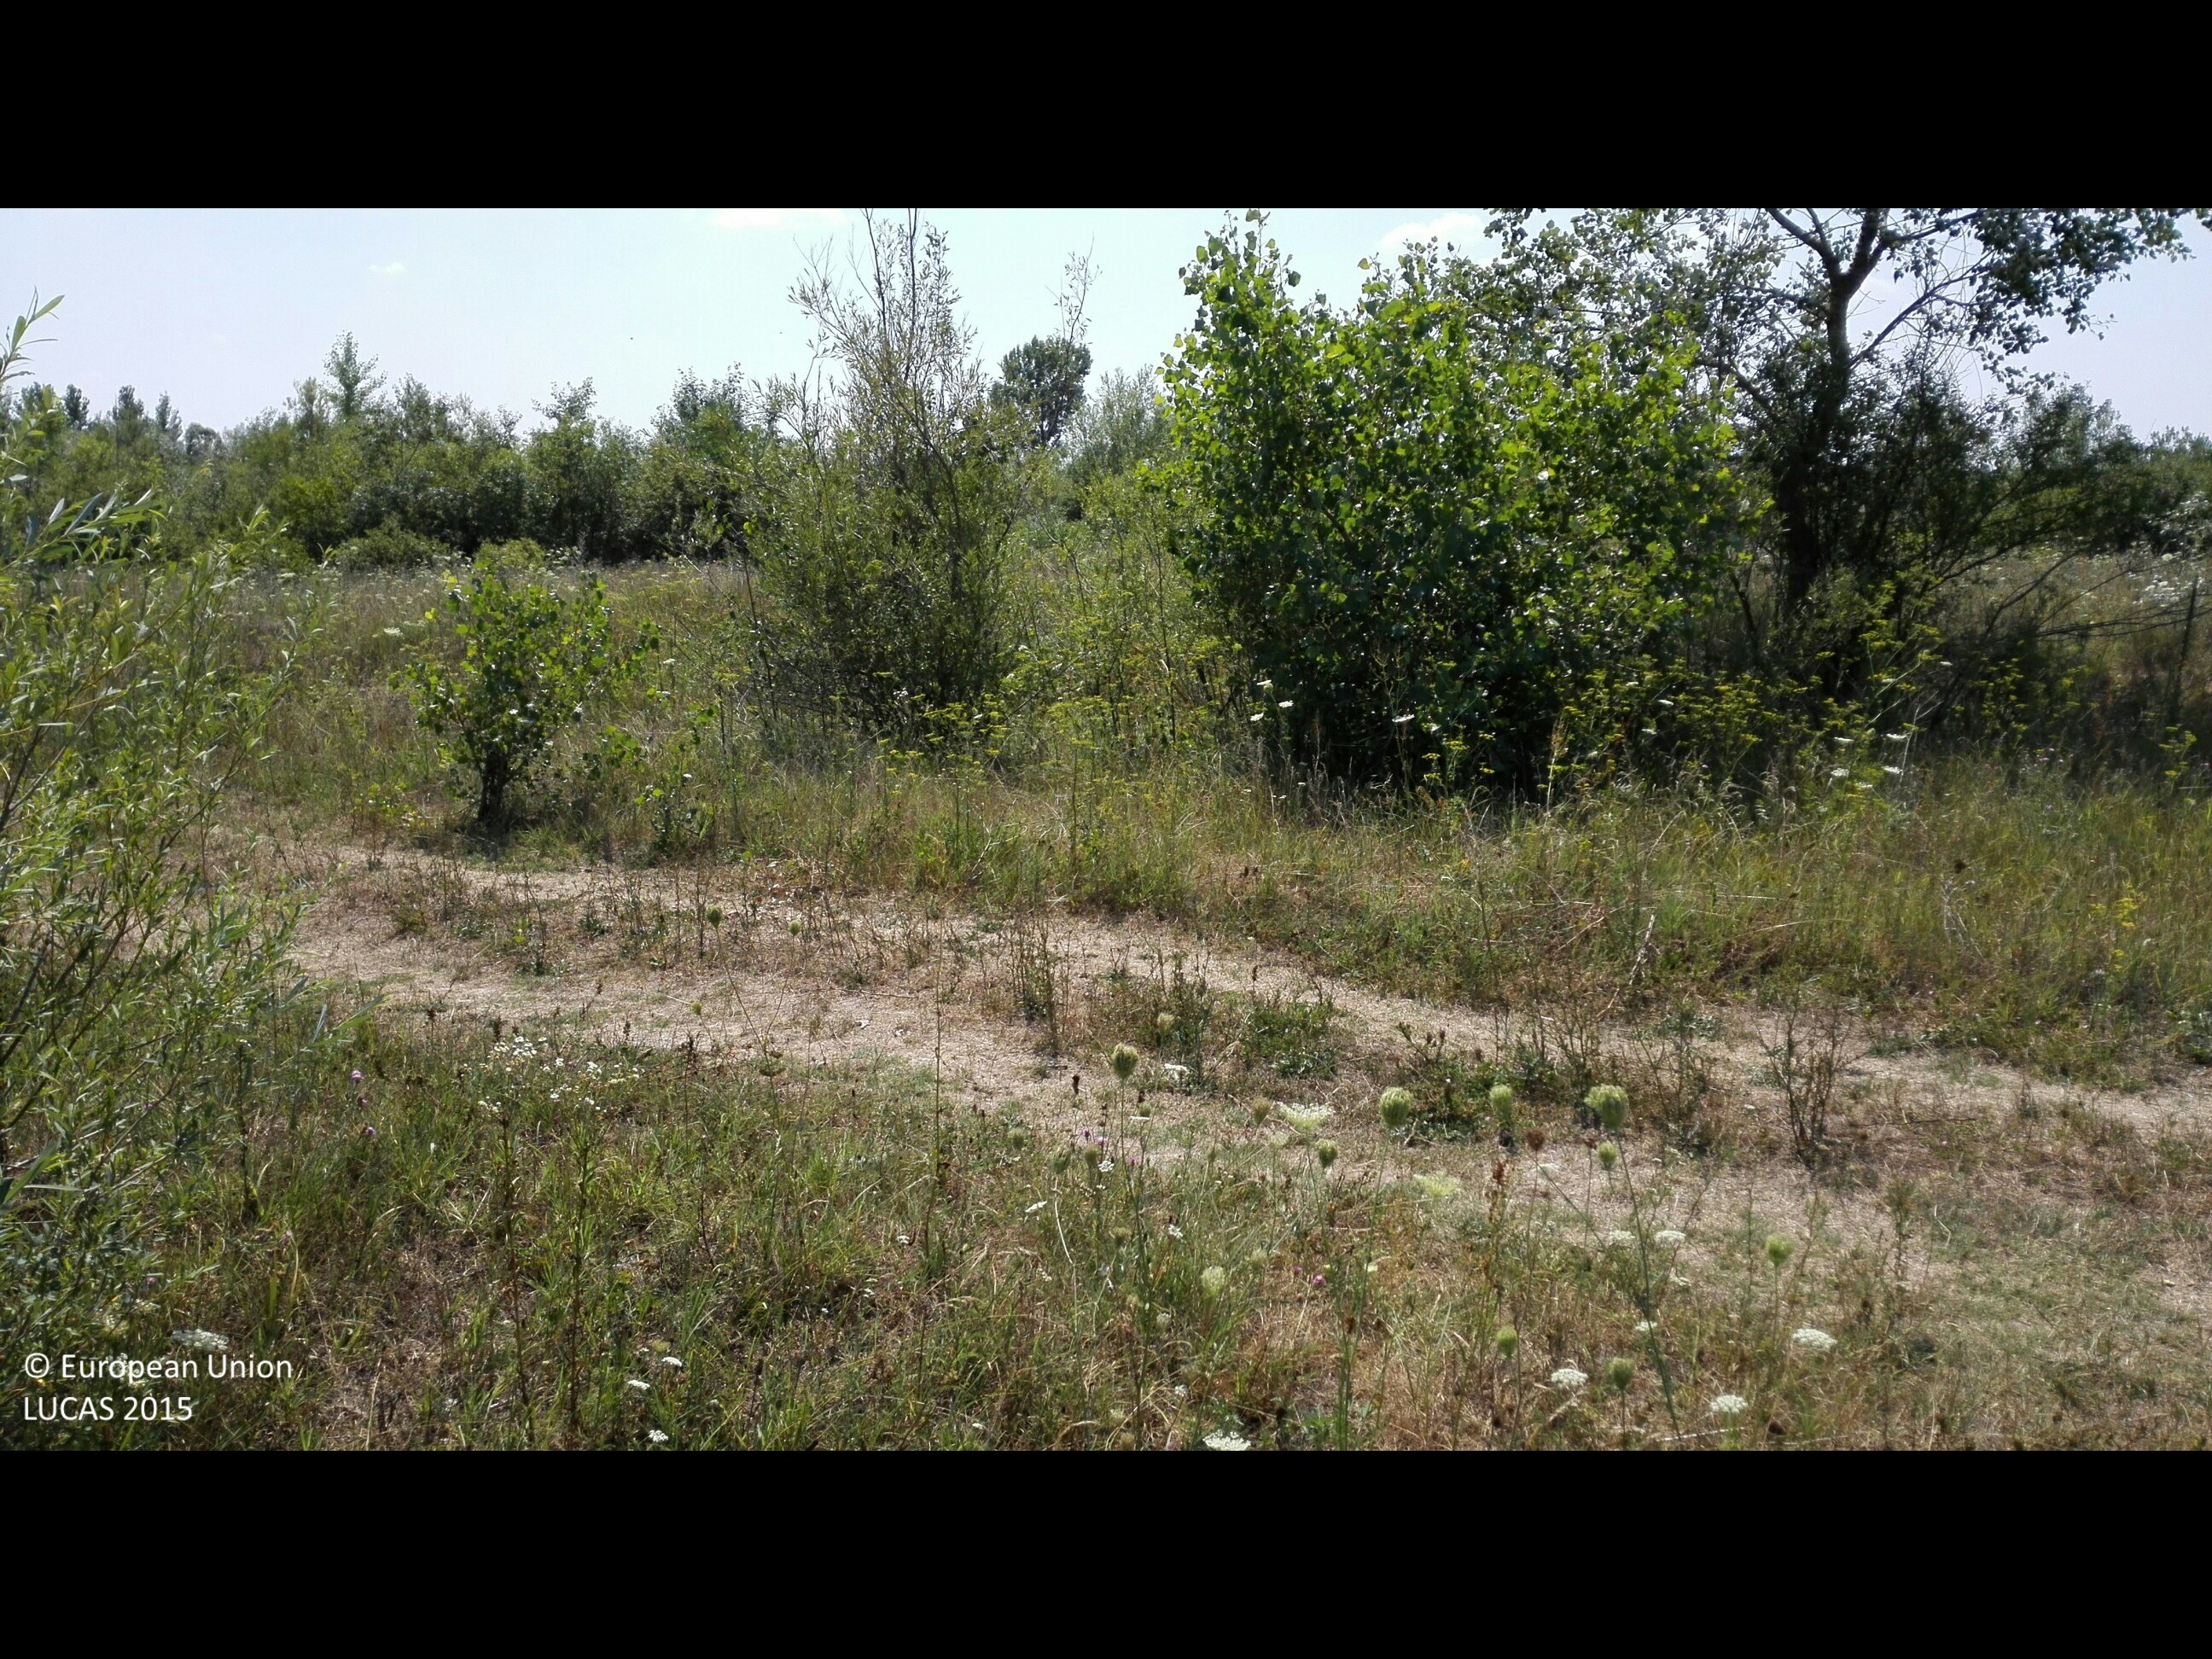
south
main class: Grassland
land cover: Grassland with sparse tree/shrub cover
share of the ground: > 75 %
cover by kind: herbaceous plants 90 %, broadleaved forest trees 5 %, shrubs 5 %
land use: Semi-natural and natural areas not in use
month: August
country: HU
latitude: 47.5625
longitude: 22.0254
